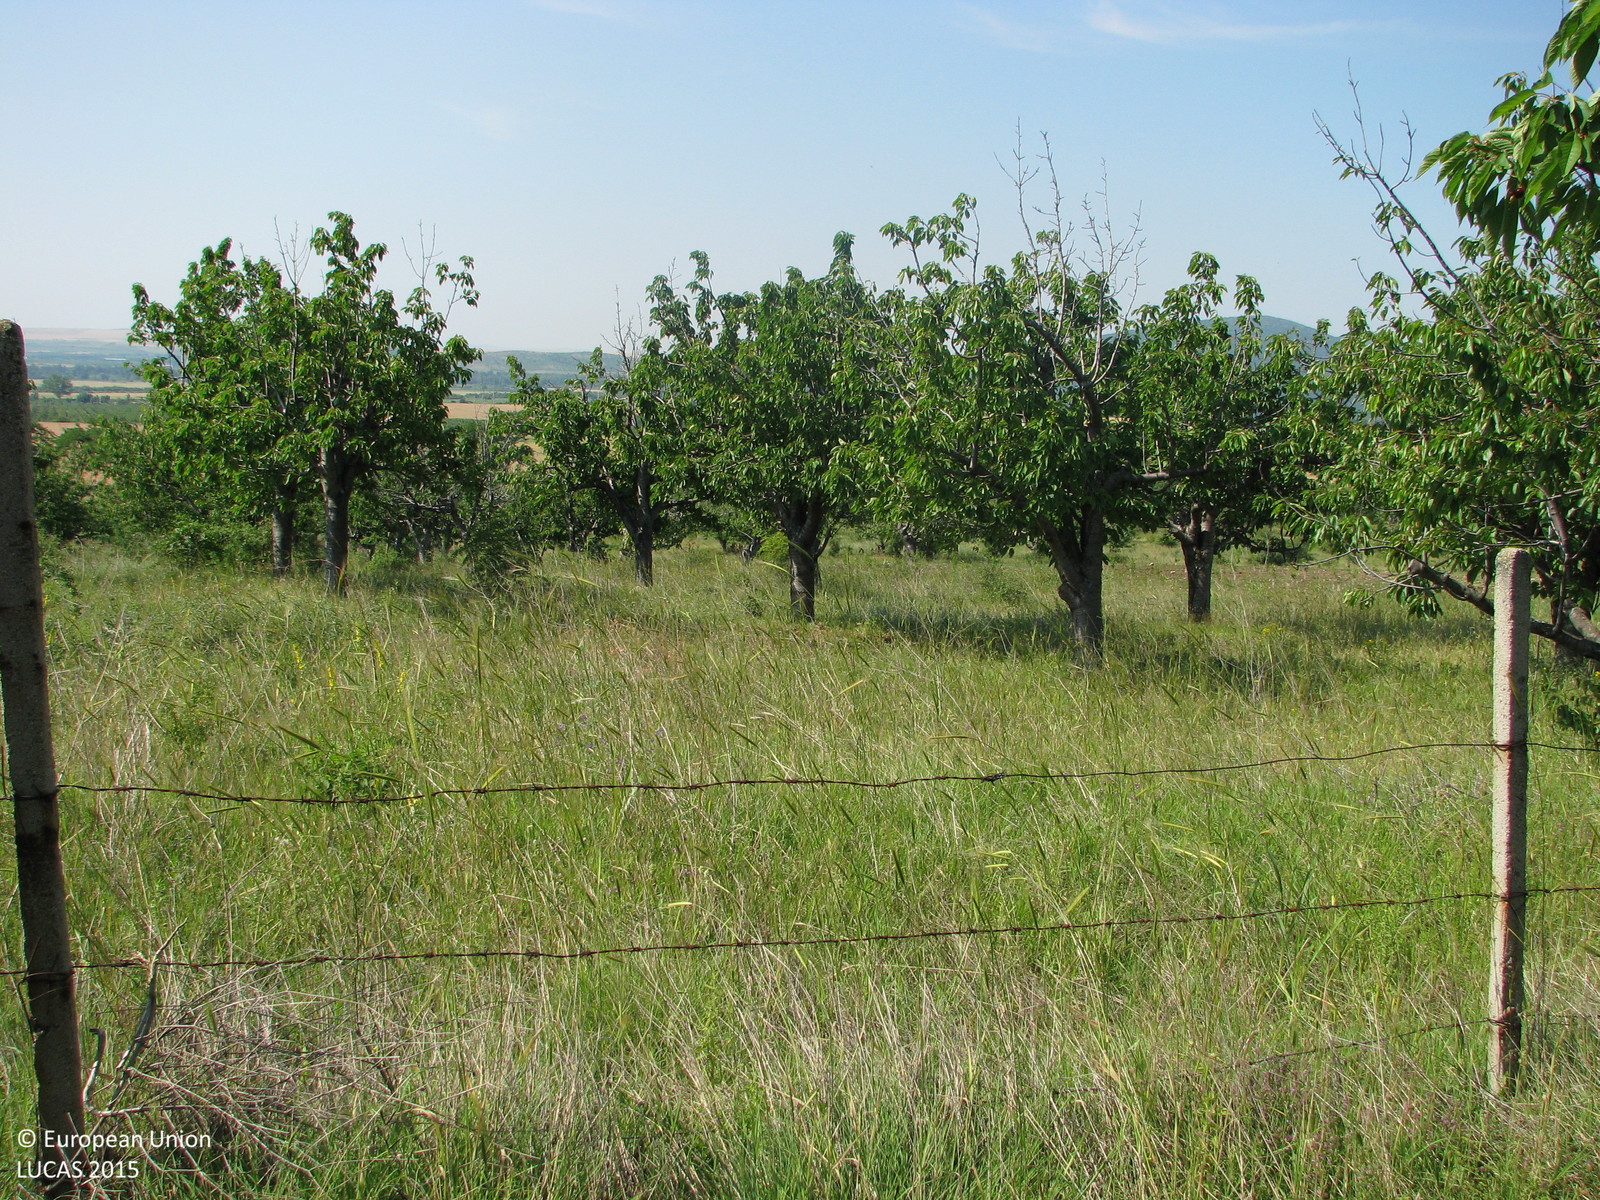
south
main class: Cropland
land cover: Cherry fruit
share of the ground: 25 - 50 %
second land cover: Spontaneously vegetated surfaces
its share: > 75 %
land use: Agriculture (excluding fallow land and kitchen gardens)
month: June
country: BG
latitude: 42.6449
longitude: 26.1990
